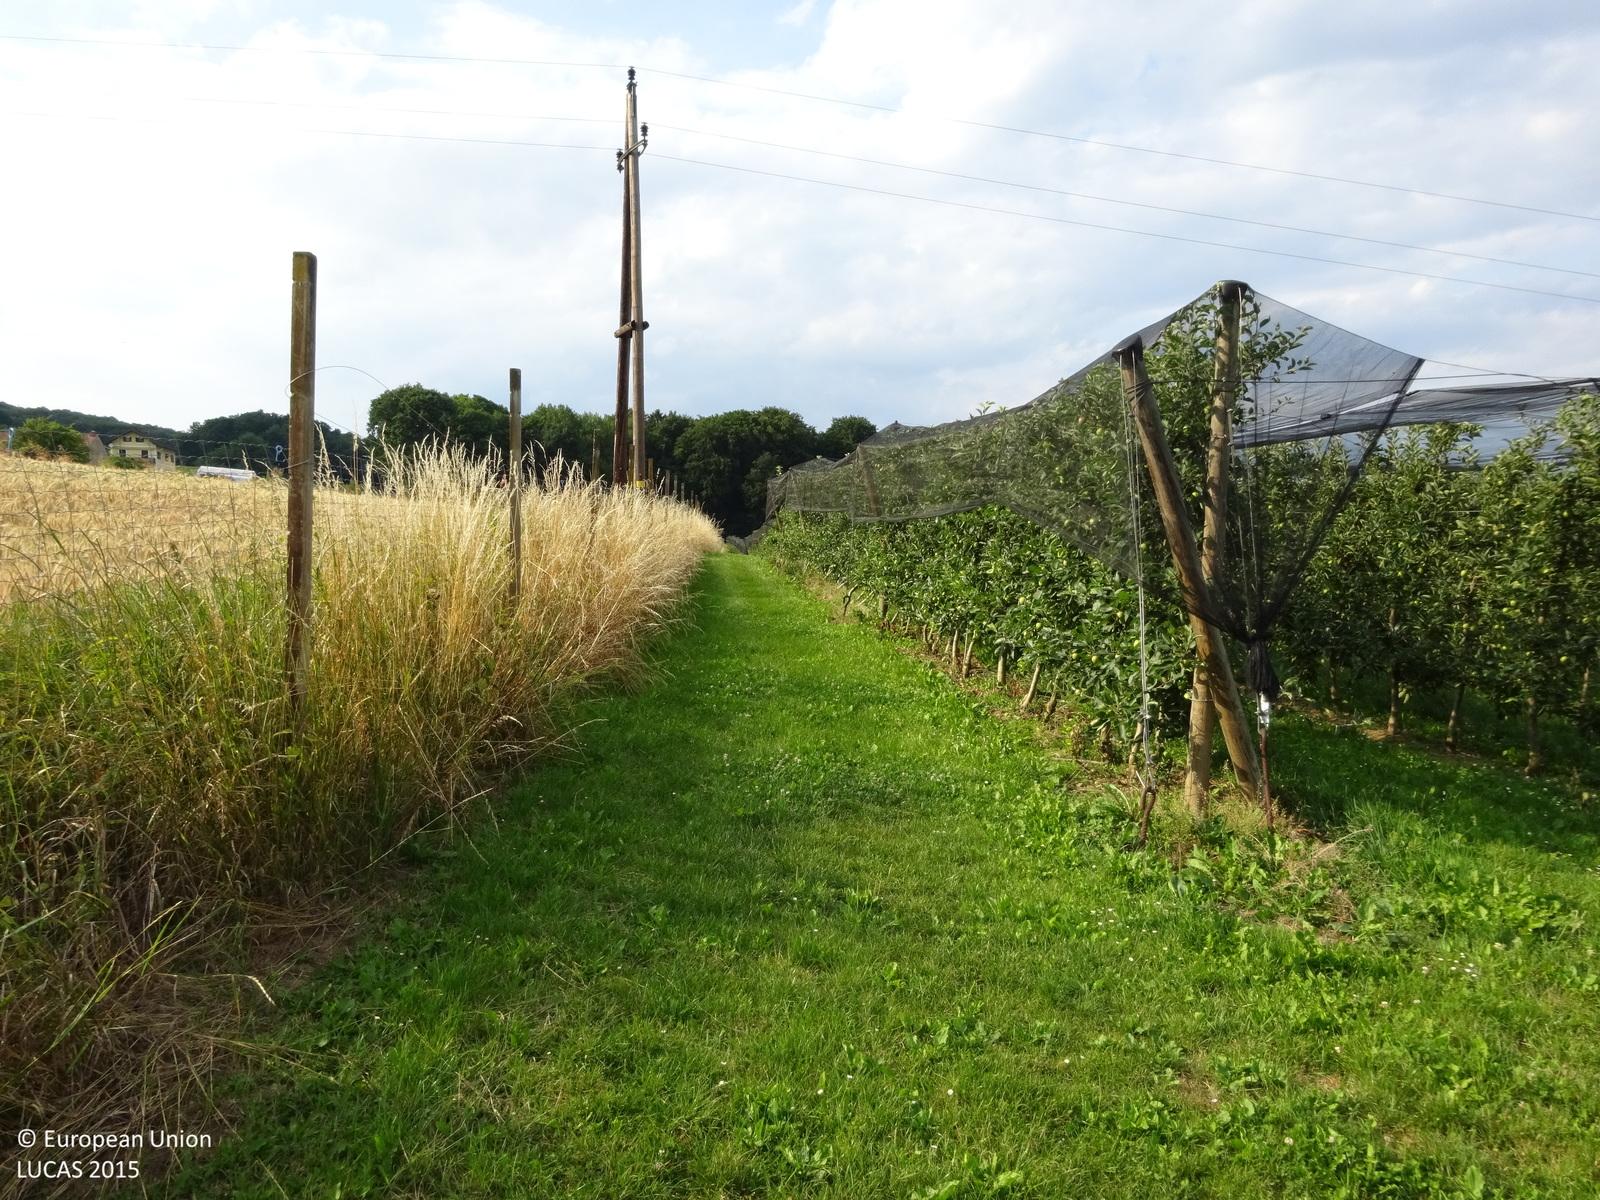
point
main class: Cropland
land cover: Apple fruit
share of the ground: > 75 %
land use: Agriculture (excluding fallow land and kitchen gardens)
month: June
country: AT
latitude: 46.8003
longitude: 15.9358
